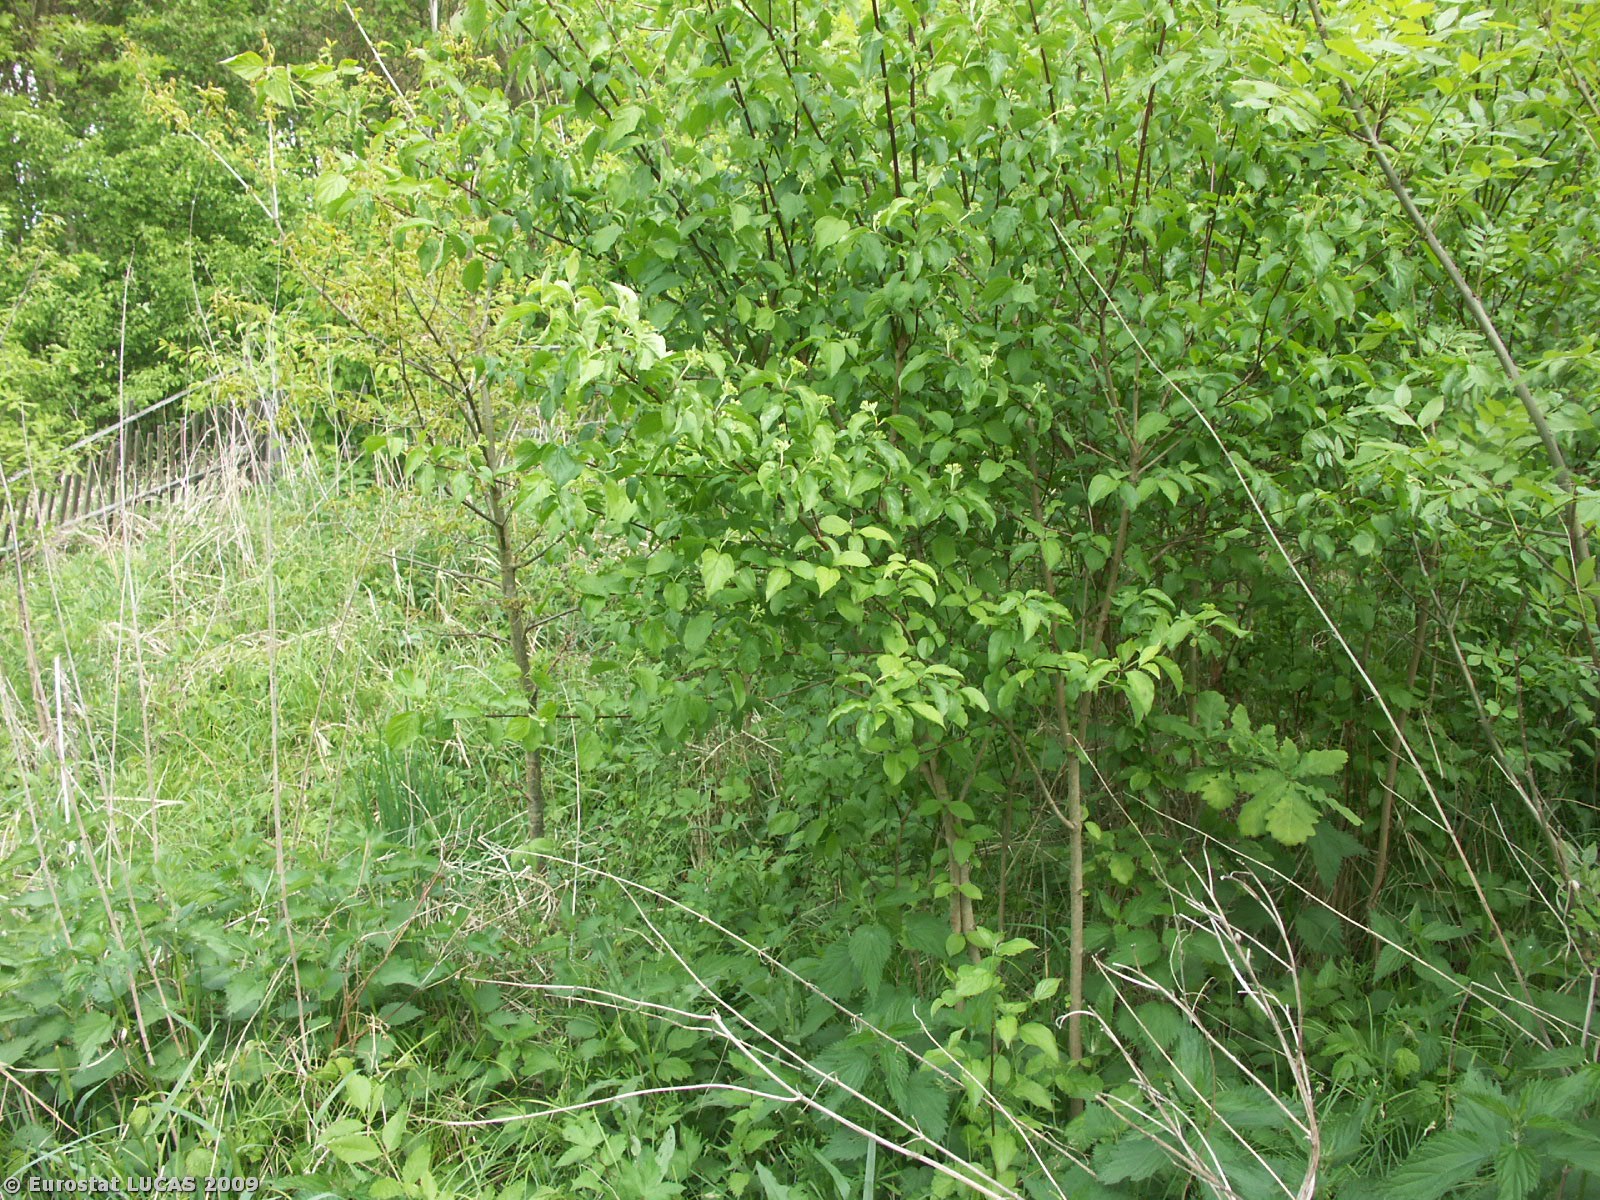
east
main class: Woodland
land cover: Broadleaved woodland
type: floodplain forest
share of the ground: > 75 %
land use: Forestry
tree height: > 5 m
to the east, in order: Broadleaved woodland; Fences; Broadleaved woodland; Tracks; Broadleaved woodland
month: May
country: CZ
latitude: 49.7068
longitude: 17.1517
